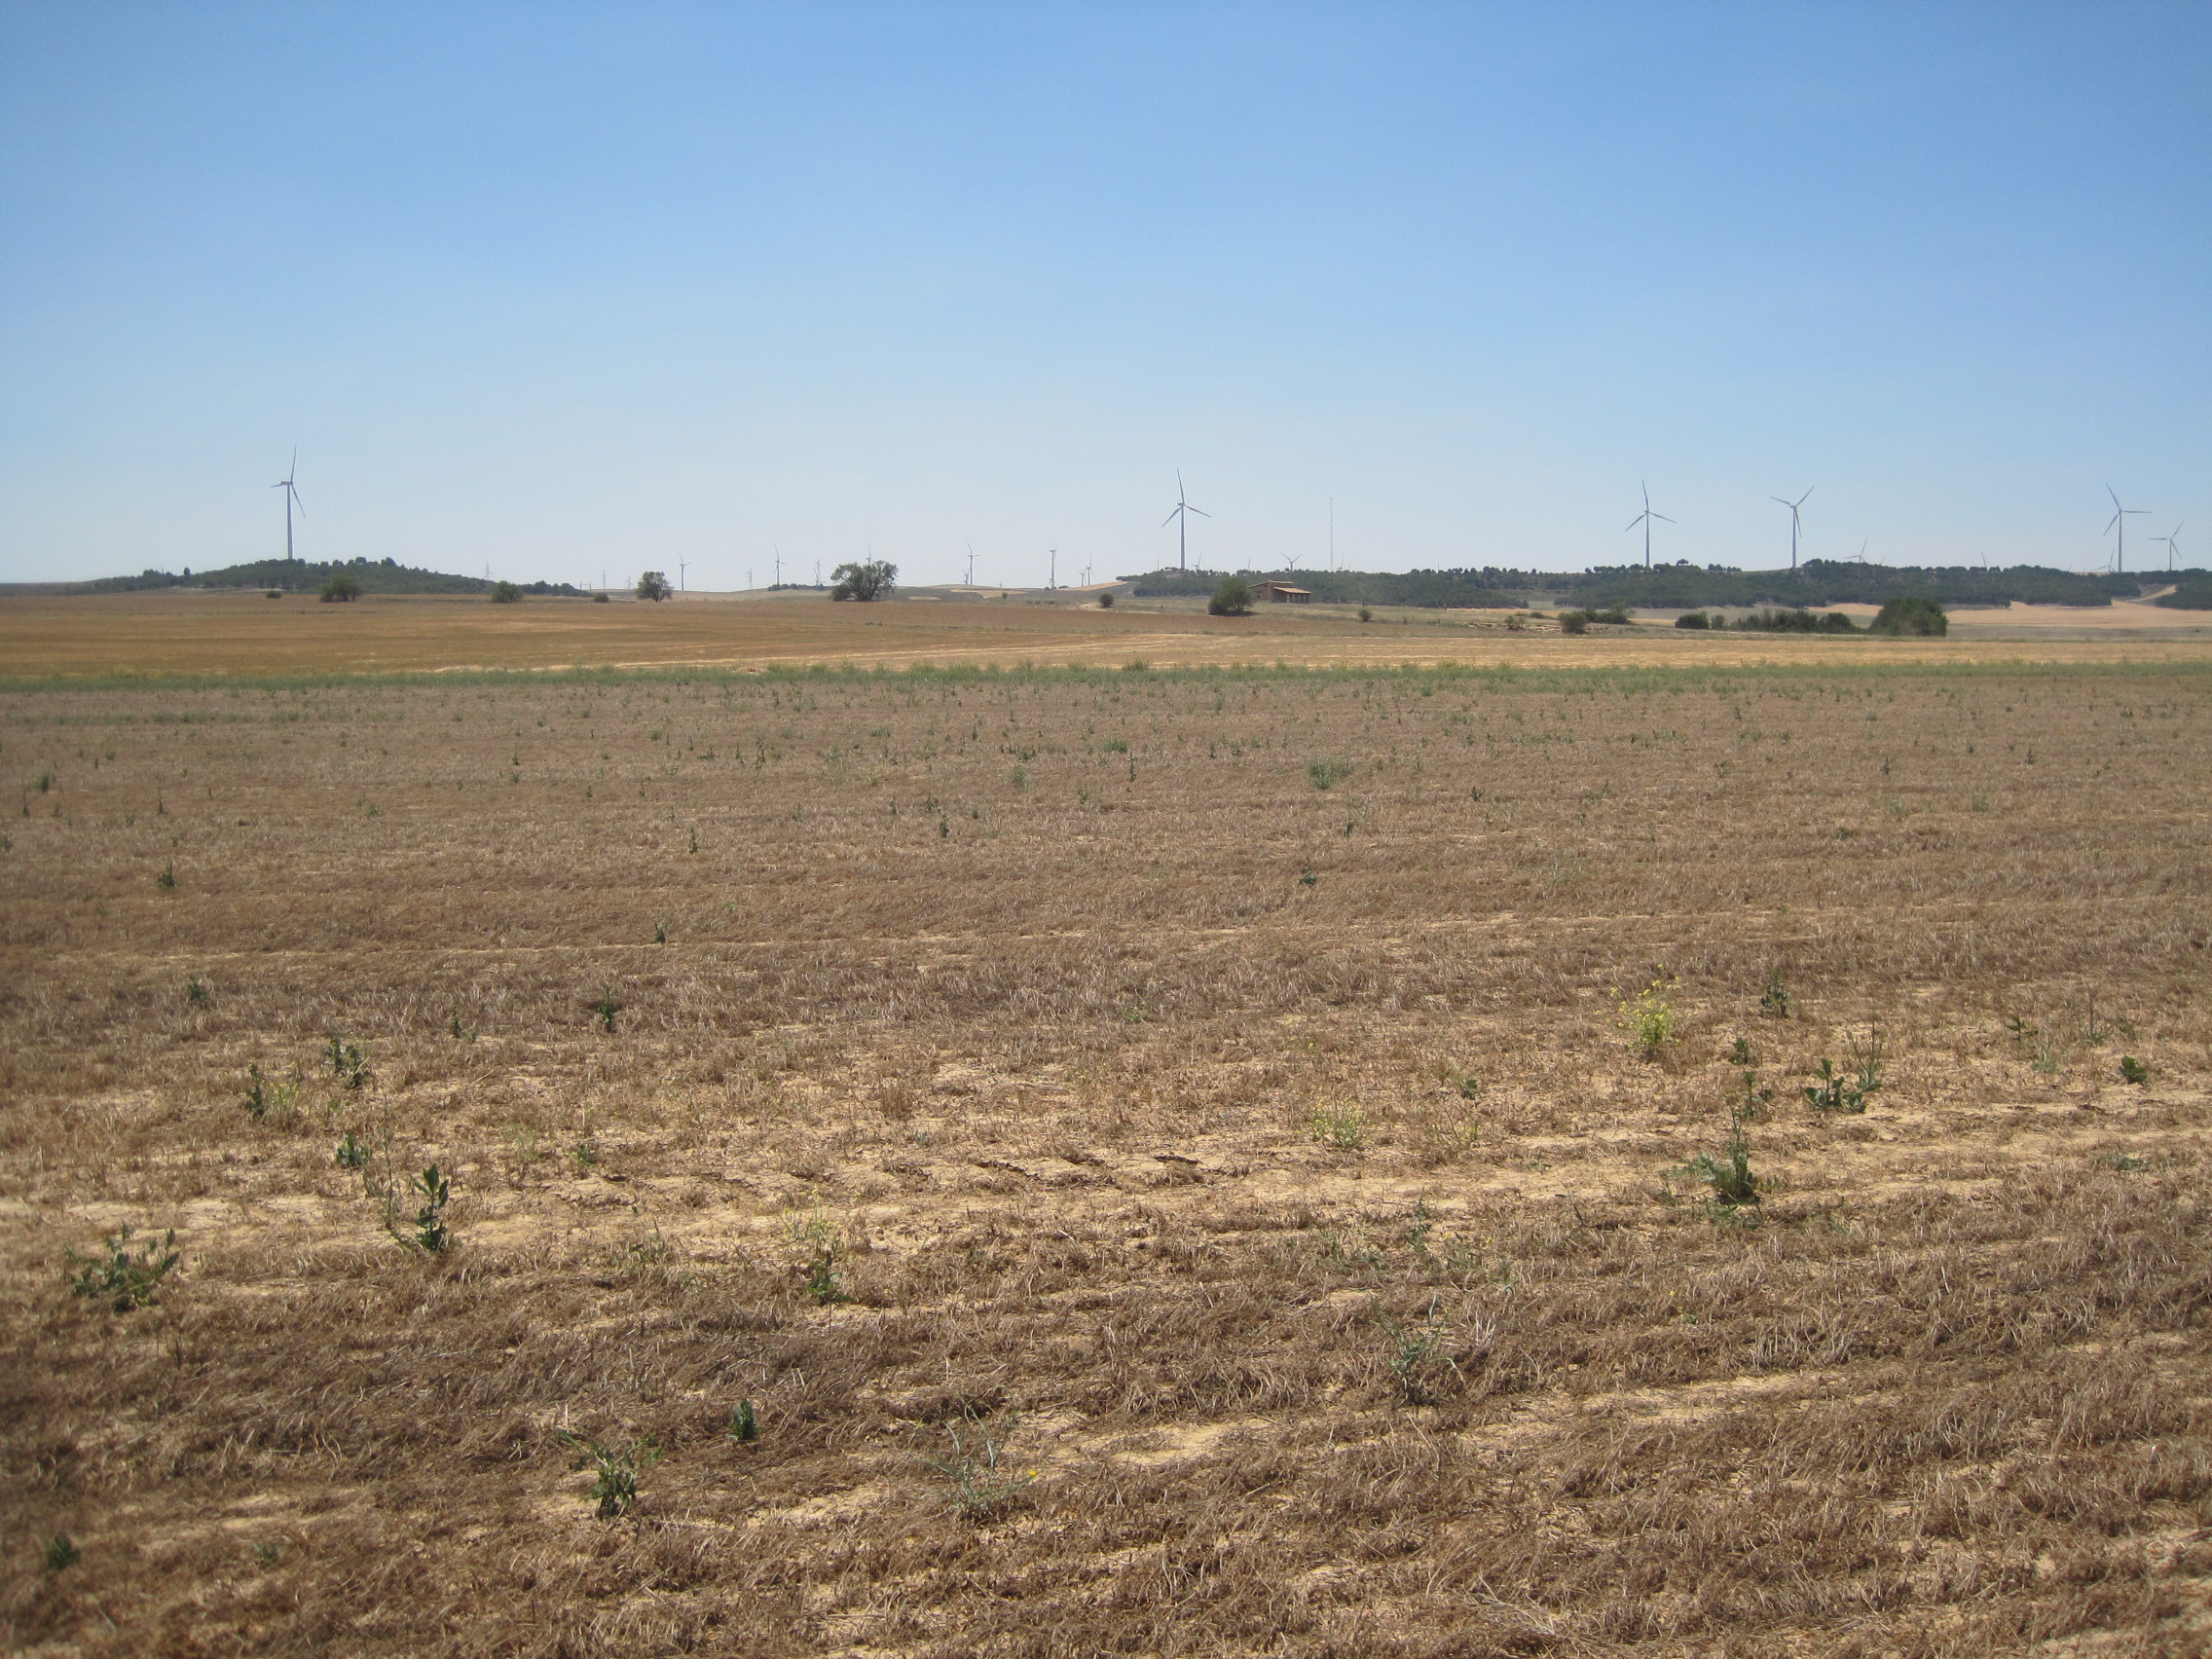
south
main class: Cropland
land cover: Dry pulses
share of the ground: < 10 %
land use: Agriculture (excluding fallow land and kitchen gardens)
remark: Harvested field
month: July
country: ES
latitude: 41.9762
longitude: -4.7118
